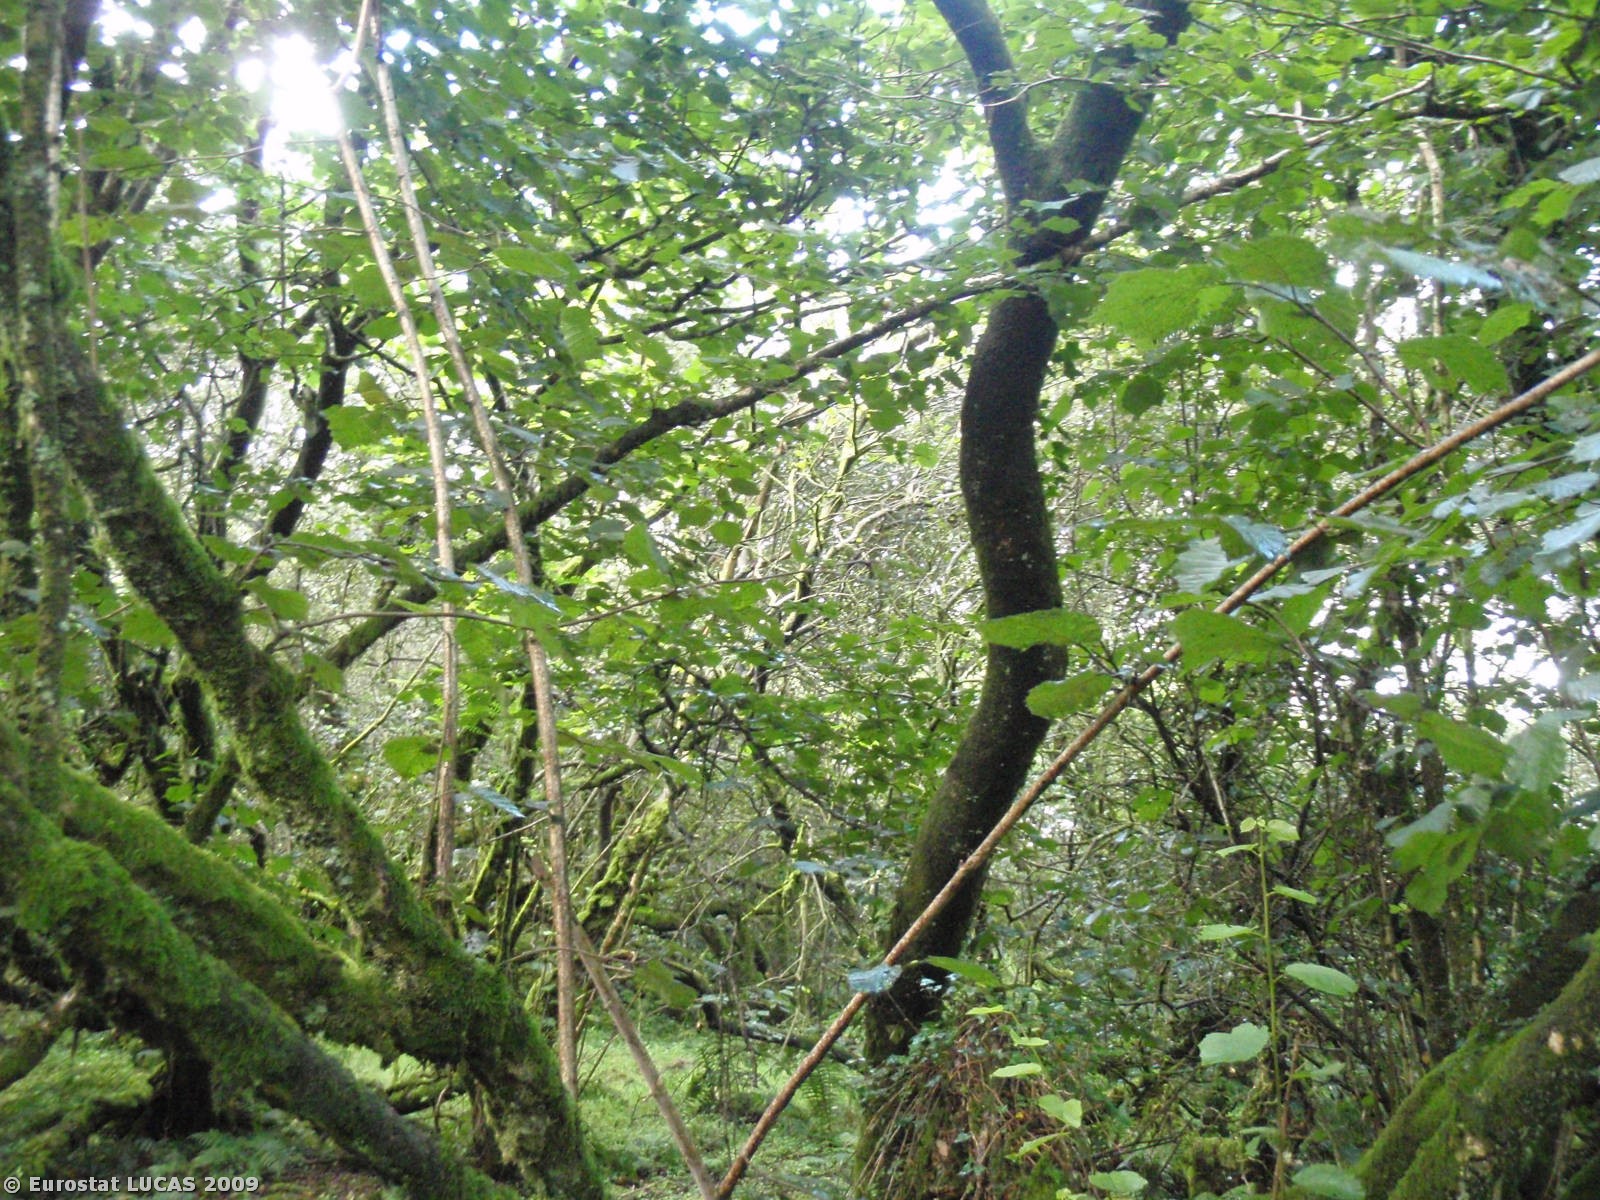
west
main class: Woodland
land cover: Broadleaved woodland
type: floodplain forest
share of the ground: > 75 %
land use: Unused
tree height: > 5 m
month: August
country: GB
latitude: 50.9265
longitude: -4.4011
